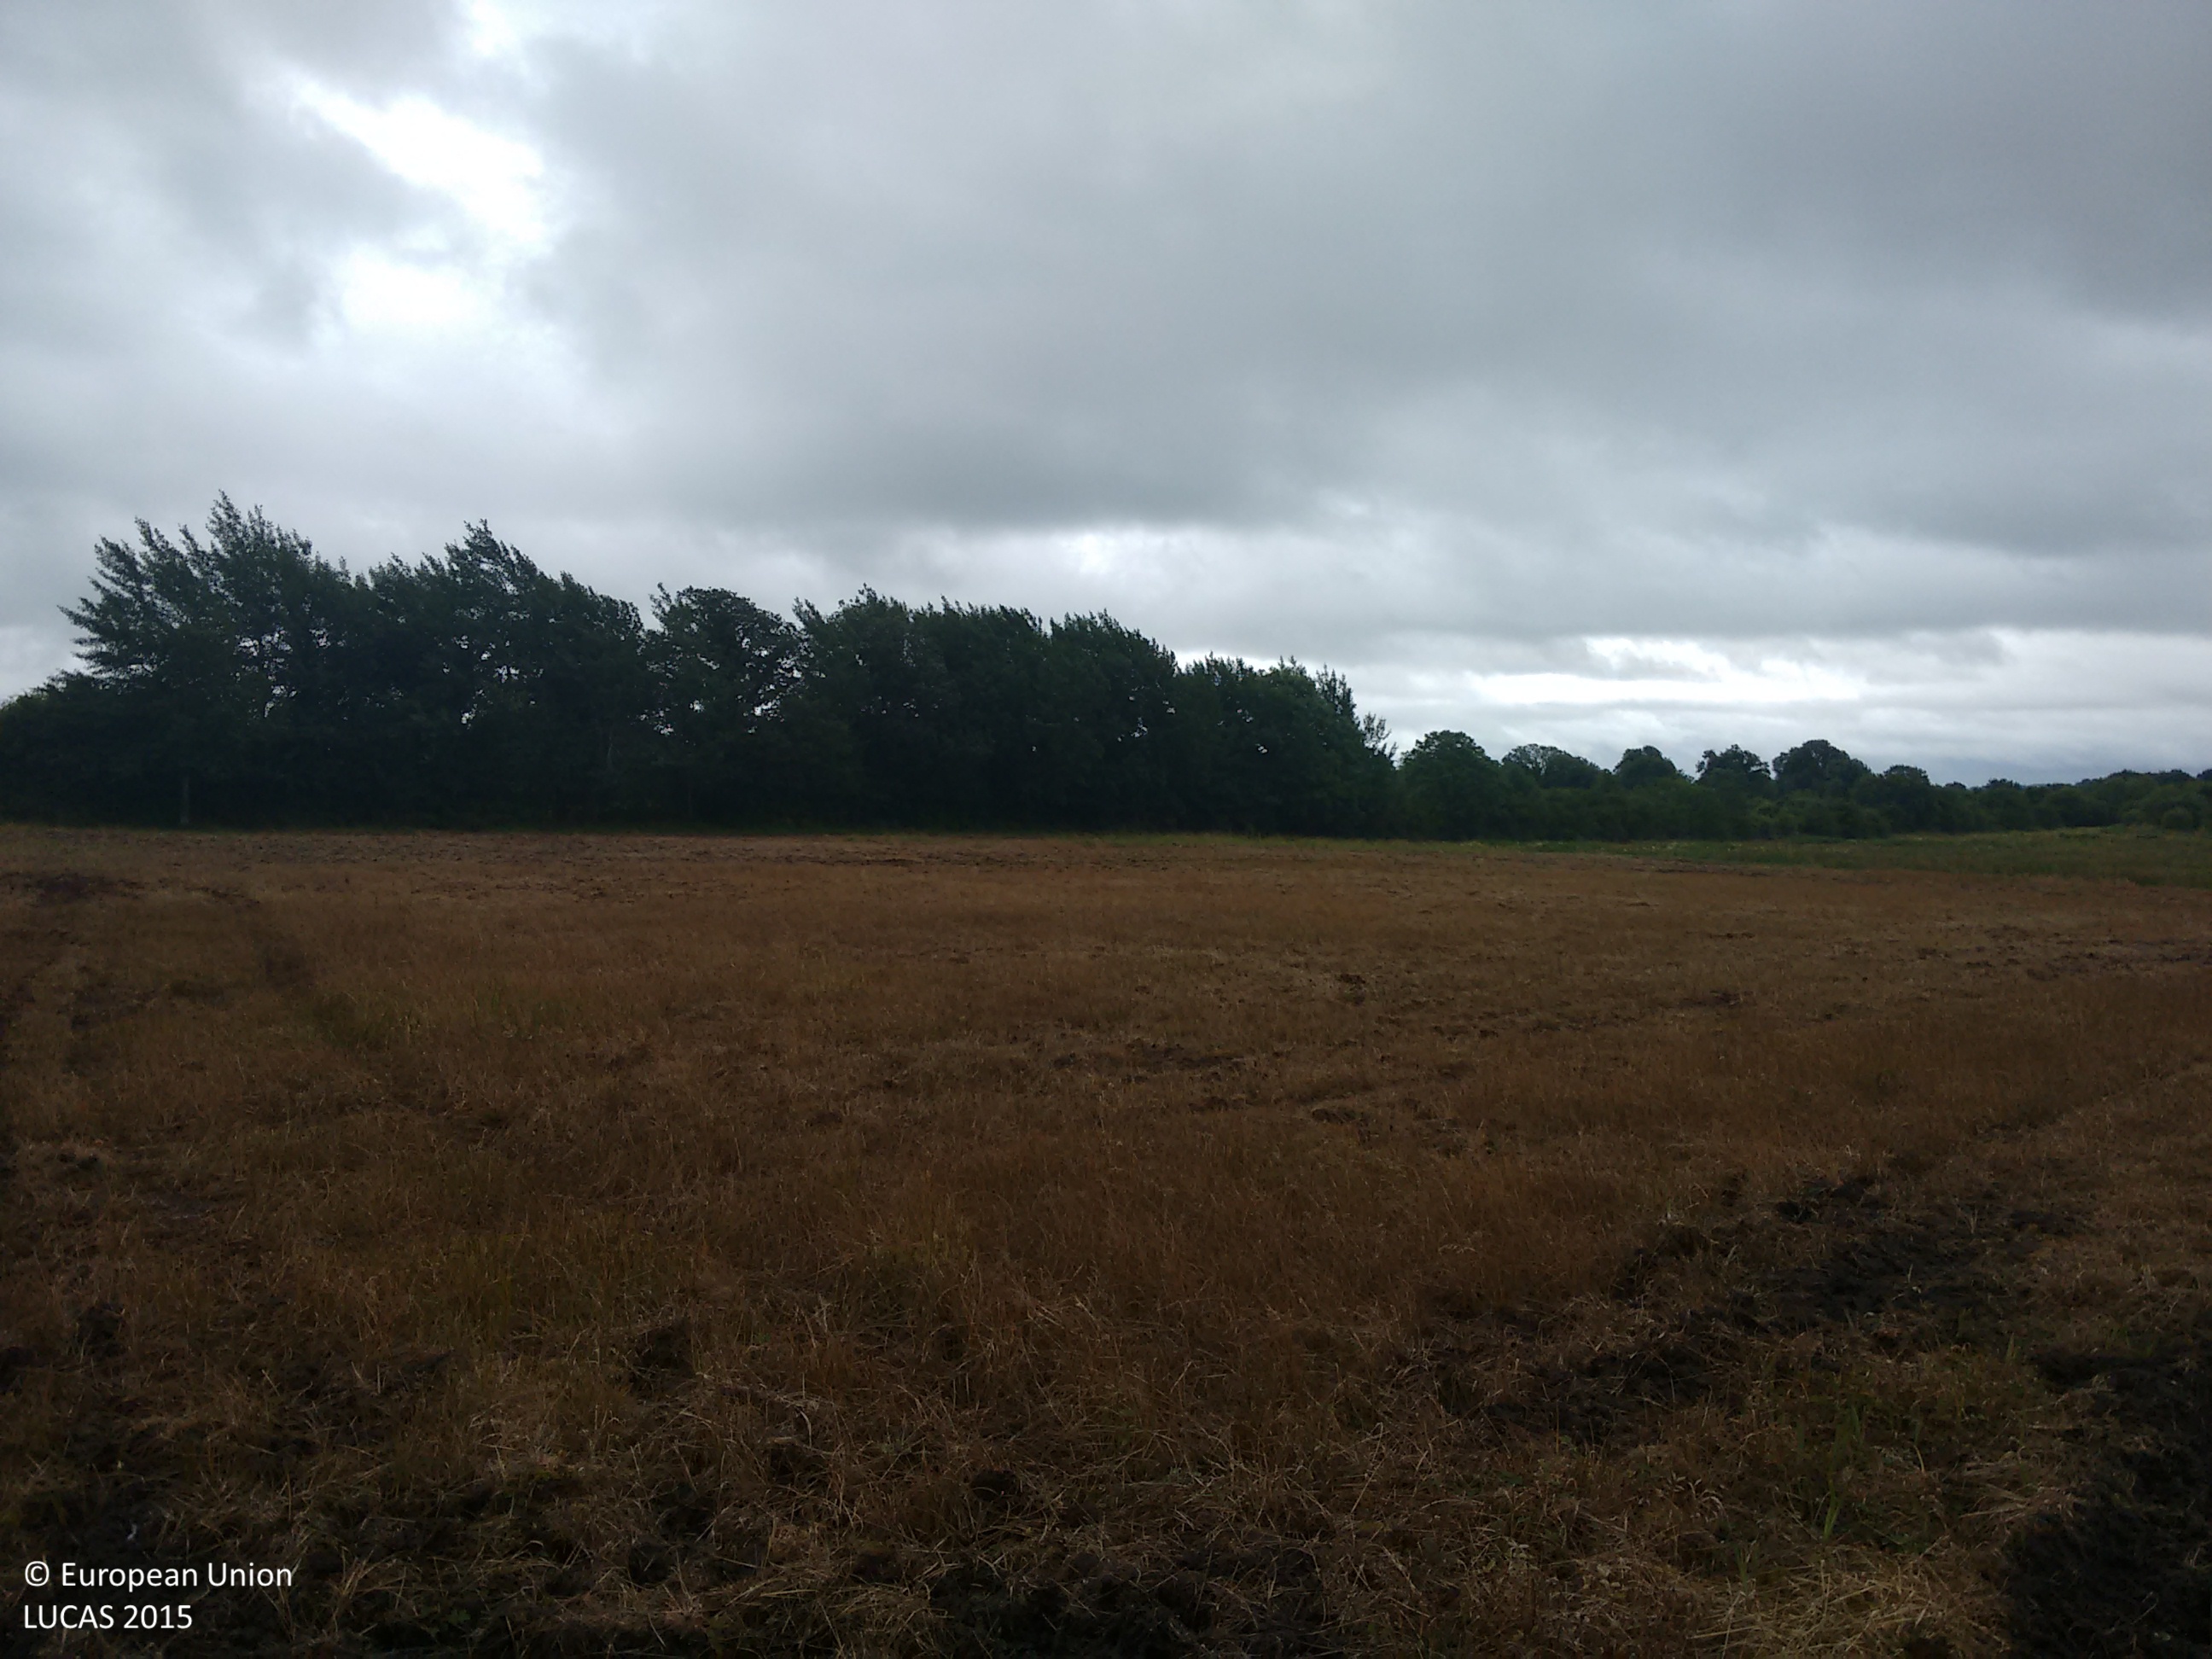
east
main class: Grassland
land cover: Spontaneously vegetated surfaces
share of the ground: 50 - 75 %
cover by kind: herbaceous plants 65 %, unconsolidated bare surface 35 %
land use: Fallow land
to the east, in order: Spontaneously vegetated surfaces; Managed hedges; Rivers and streams; Inland marshes; Managed hedges; Ditches and canals; Managed hedges; Grassland without tree/shrub cover
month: July
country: IE
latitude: 53.5892
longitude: -7.7355
